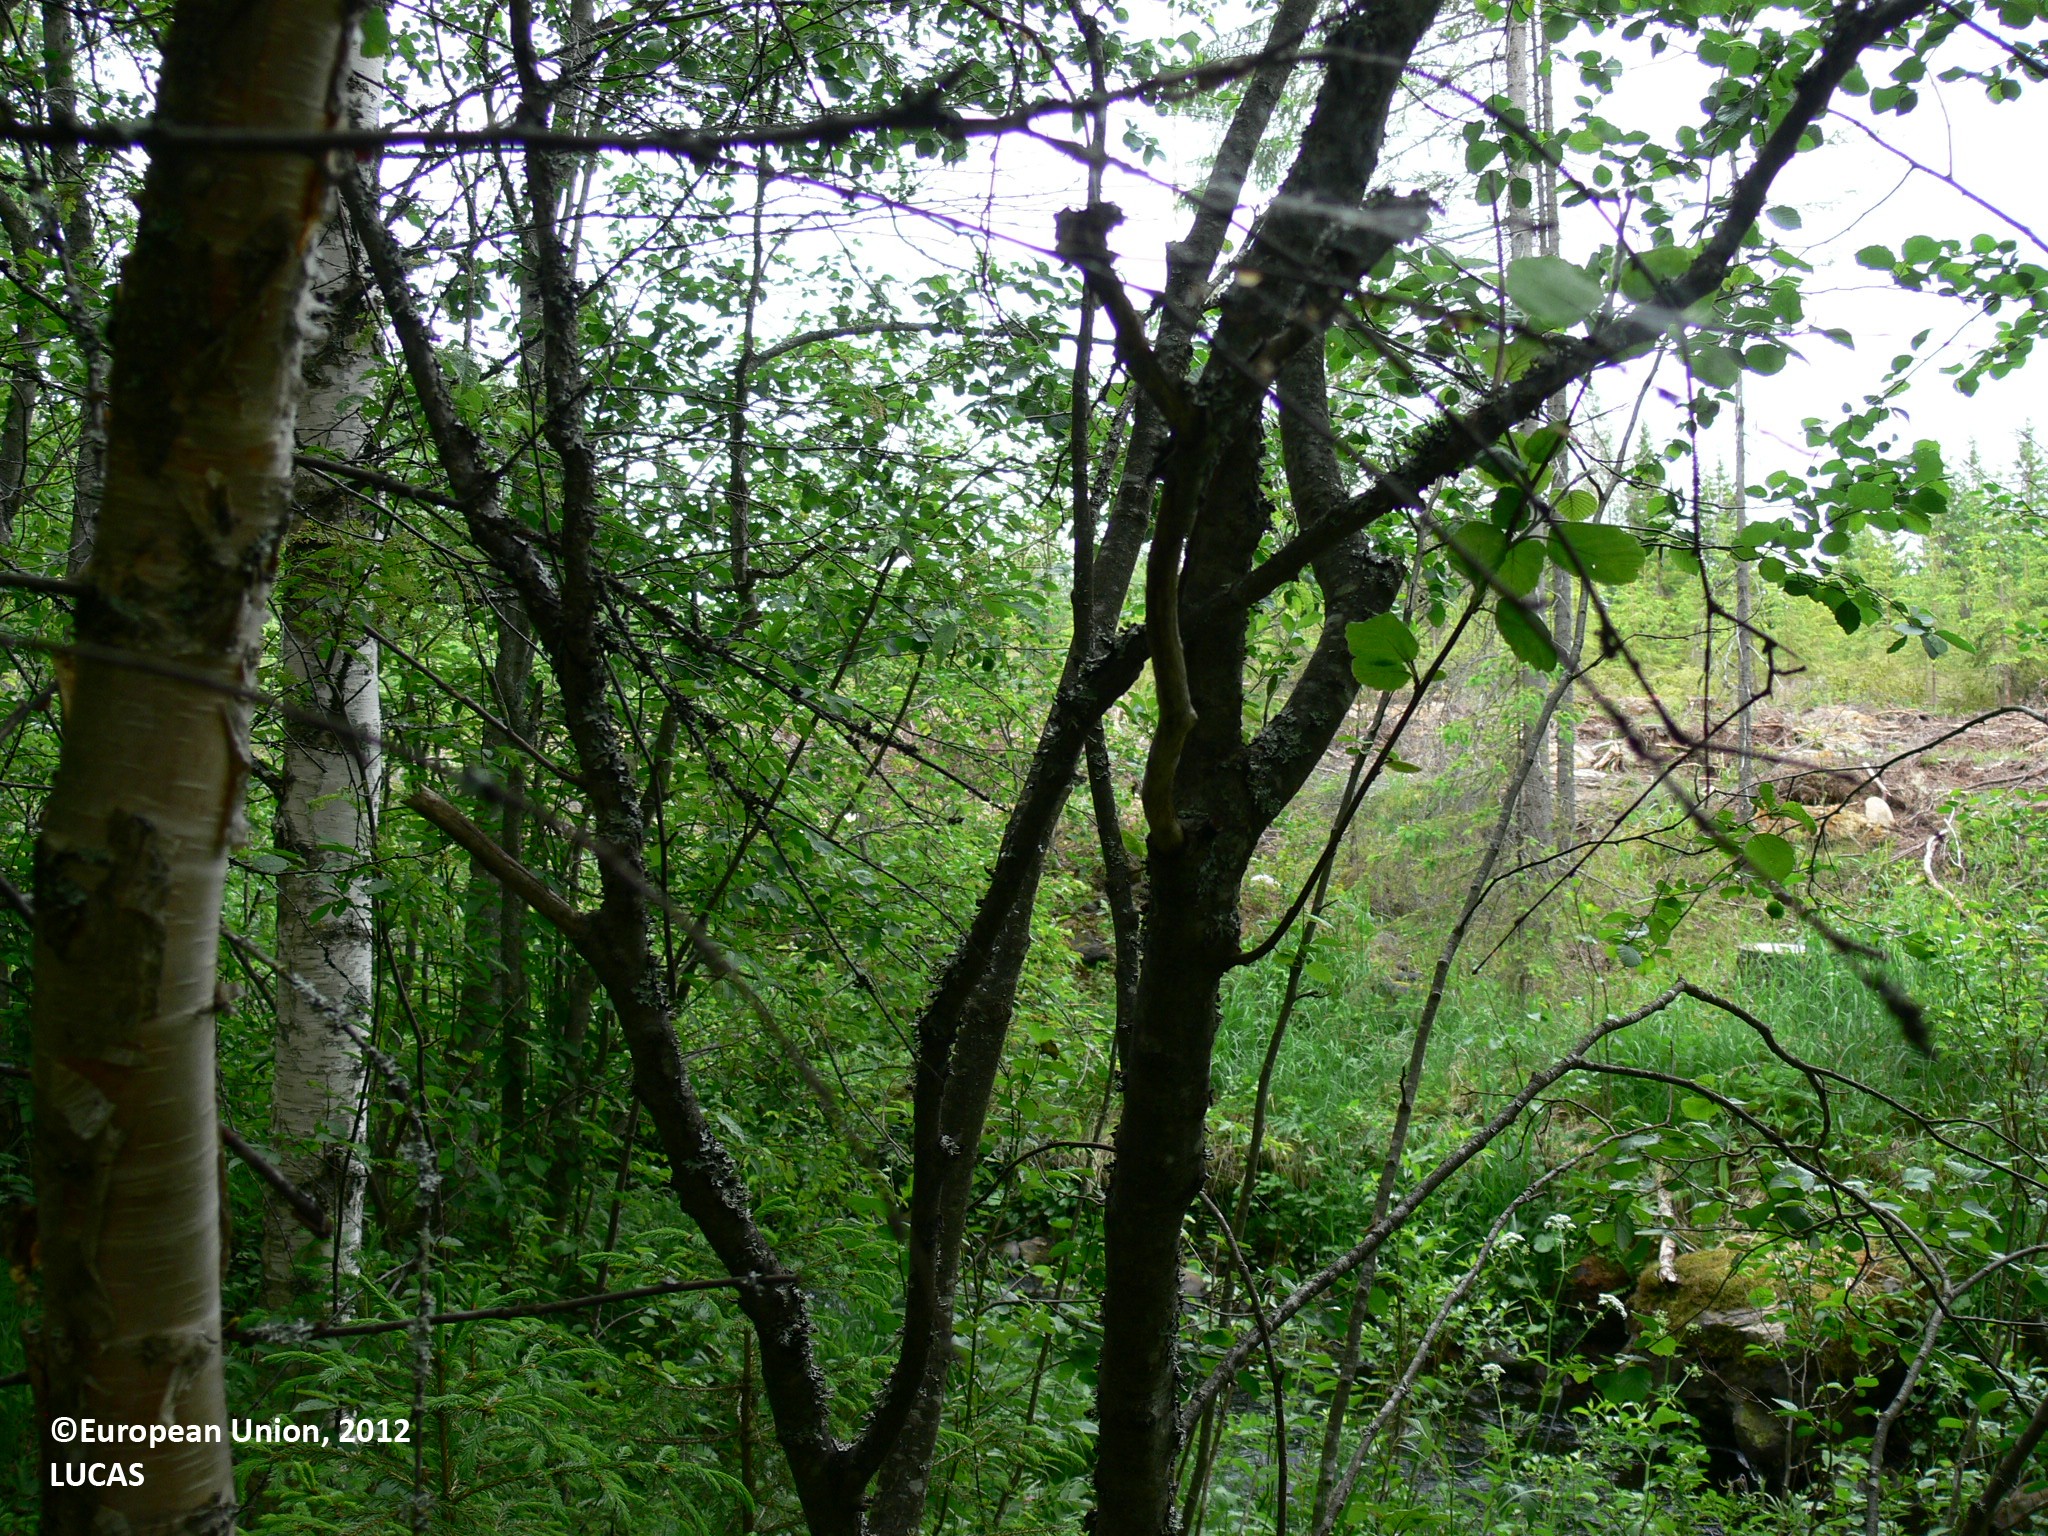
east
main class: Woodland
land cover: Spruce dominated mixed woodland
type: boreal forest
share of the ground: > 75 %
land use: Forestry
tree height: > 5 m
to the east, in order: Spruce dominated mixed woodland; Rivers and streams; Spruce dominated coniferous woodland; Other bare soil; Grass margins; Paved roads, cycling and walking lanes; Shruby margins; Ditches and canals; Other mixed woodland; Ditches and canals; Pine dominated mixed woodland; Tracks; Pine dominated coniferous woodland
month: June
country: FI
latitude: 63.0229
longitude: 29.7455
